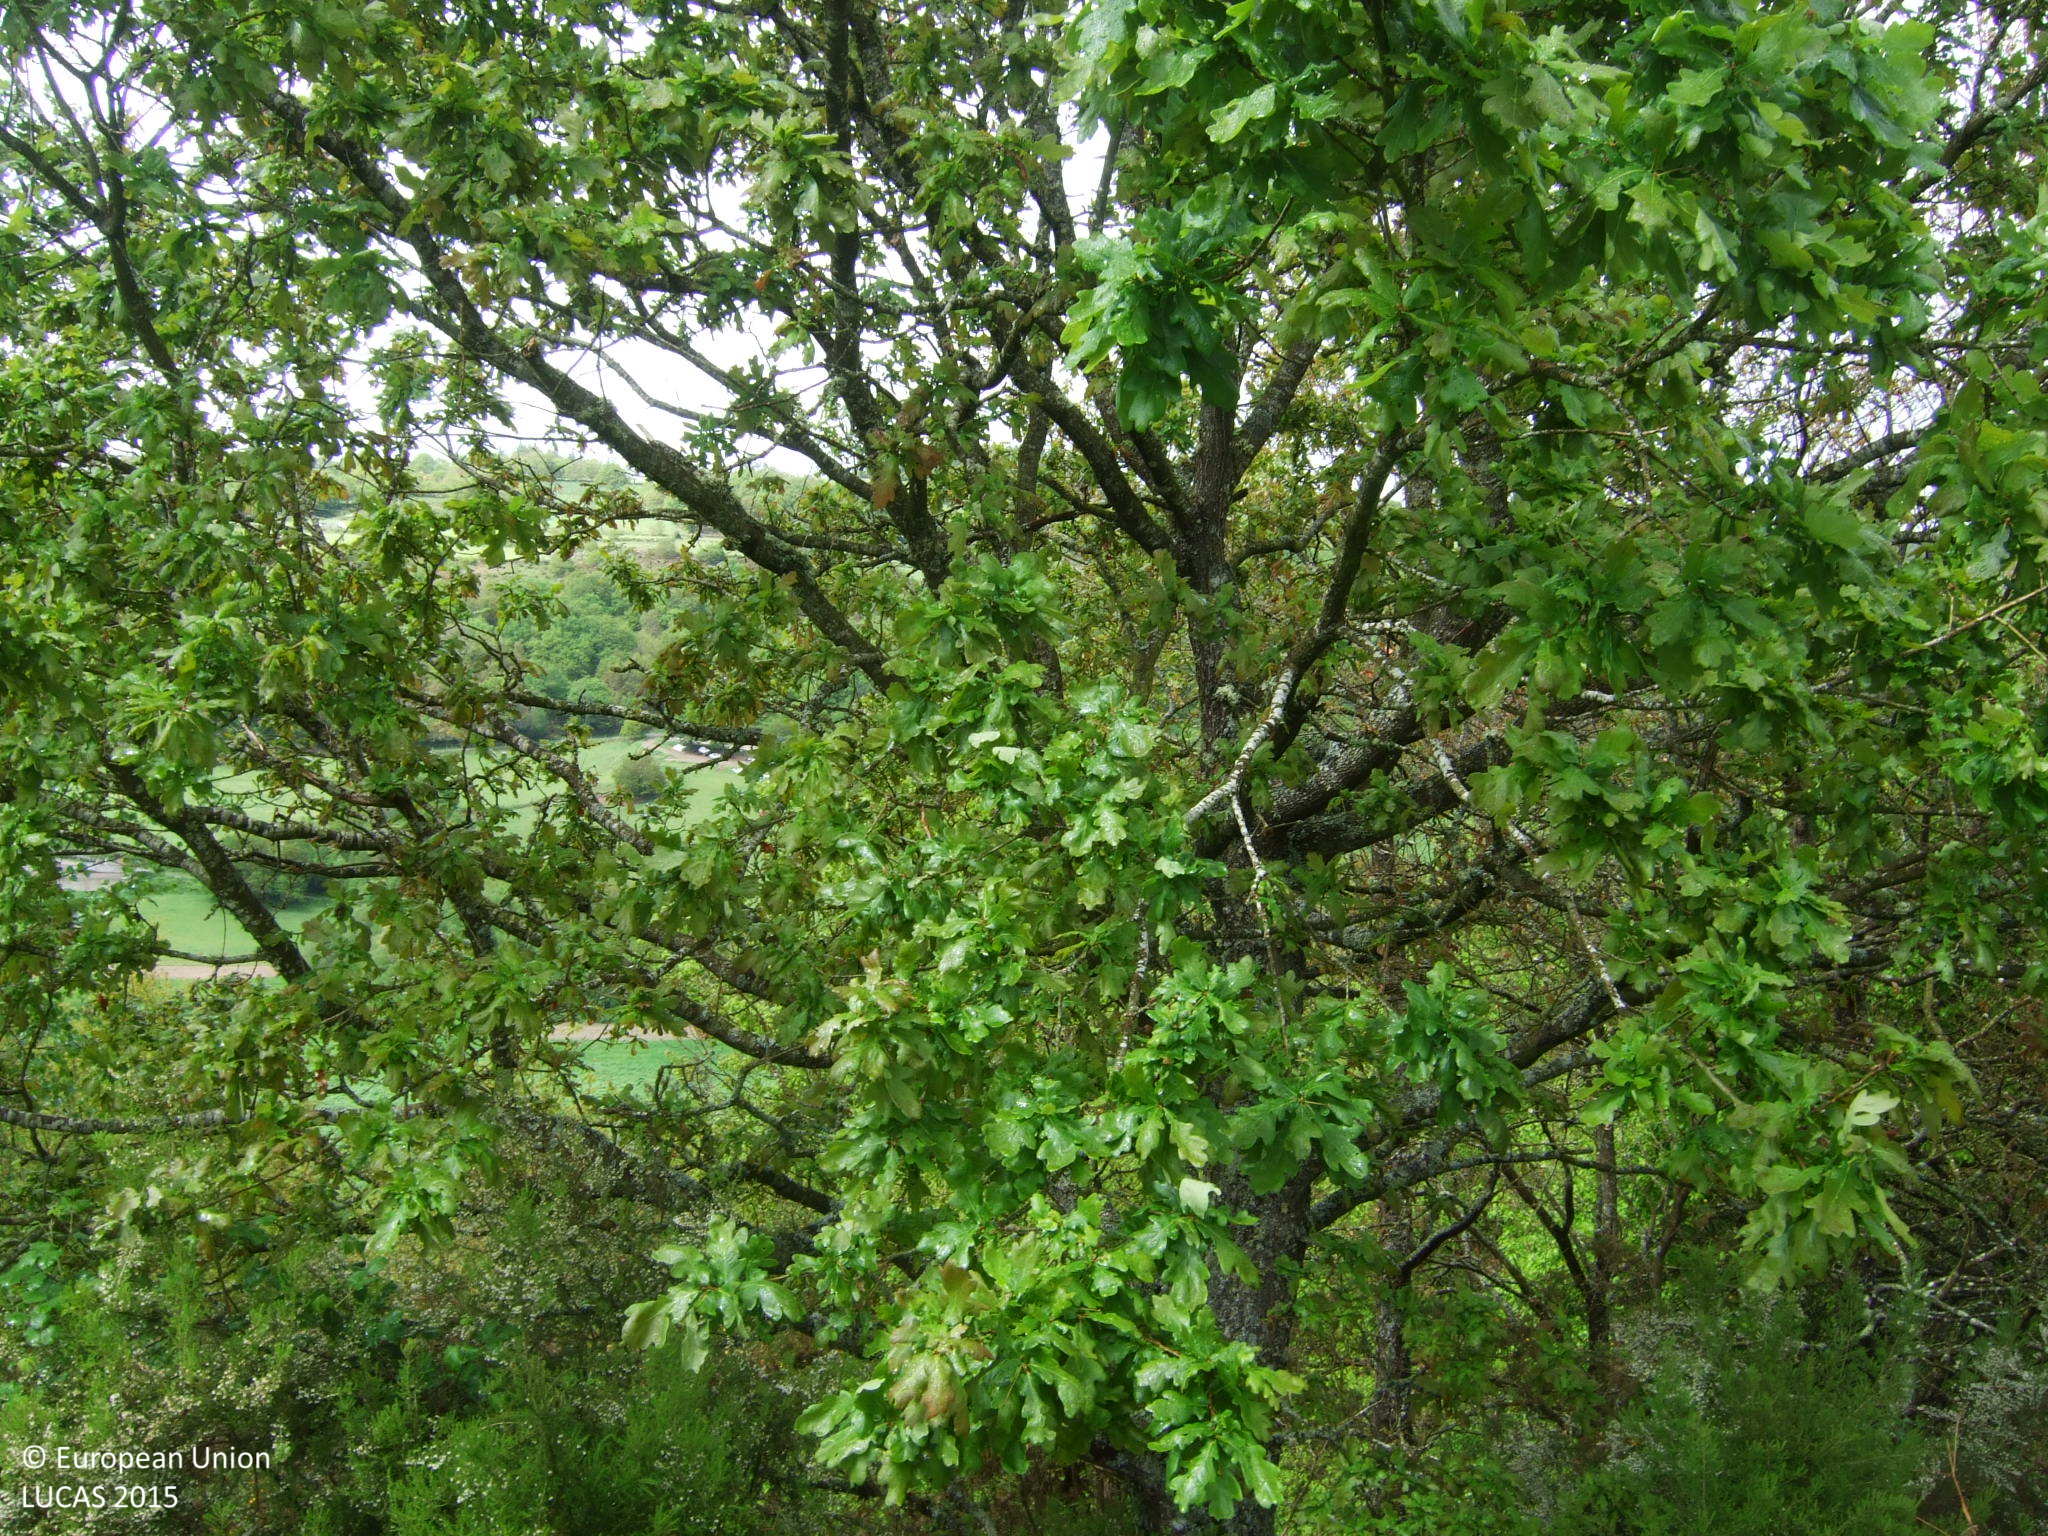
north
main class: Grassland
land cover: Grassland without tree/shrub cover
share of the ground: > 75 %
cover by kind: herbaceous plants 100 %
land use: Agriculture (excluding fallow land and kitchen gardens)
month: May
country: ES
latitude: 42.7689
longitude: -7.5375
